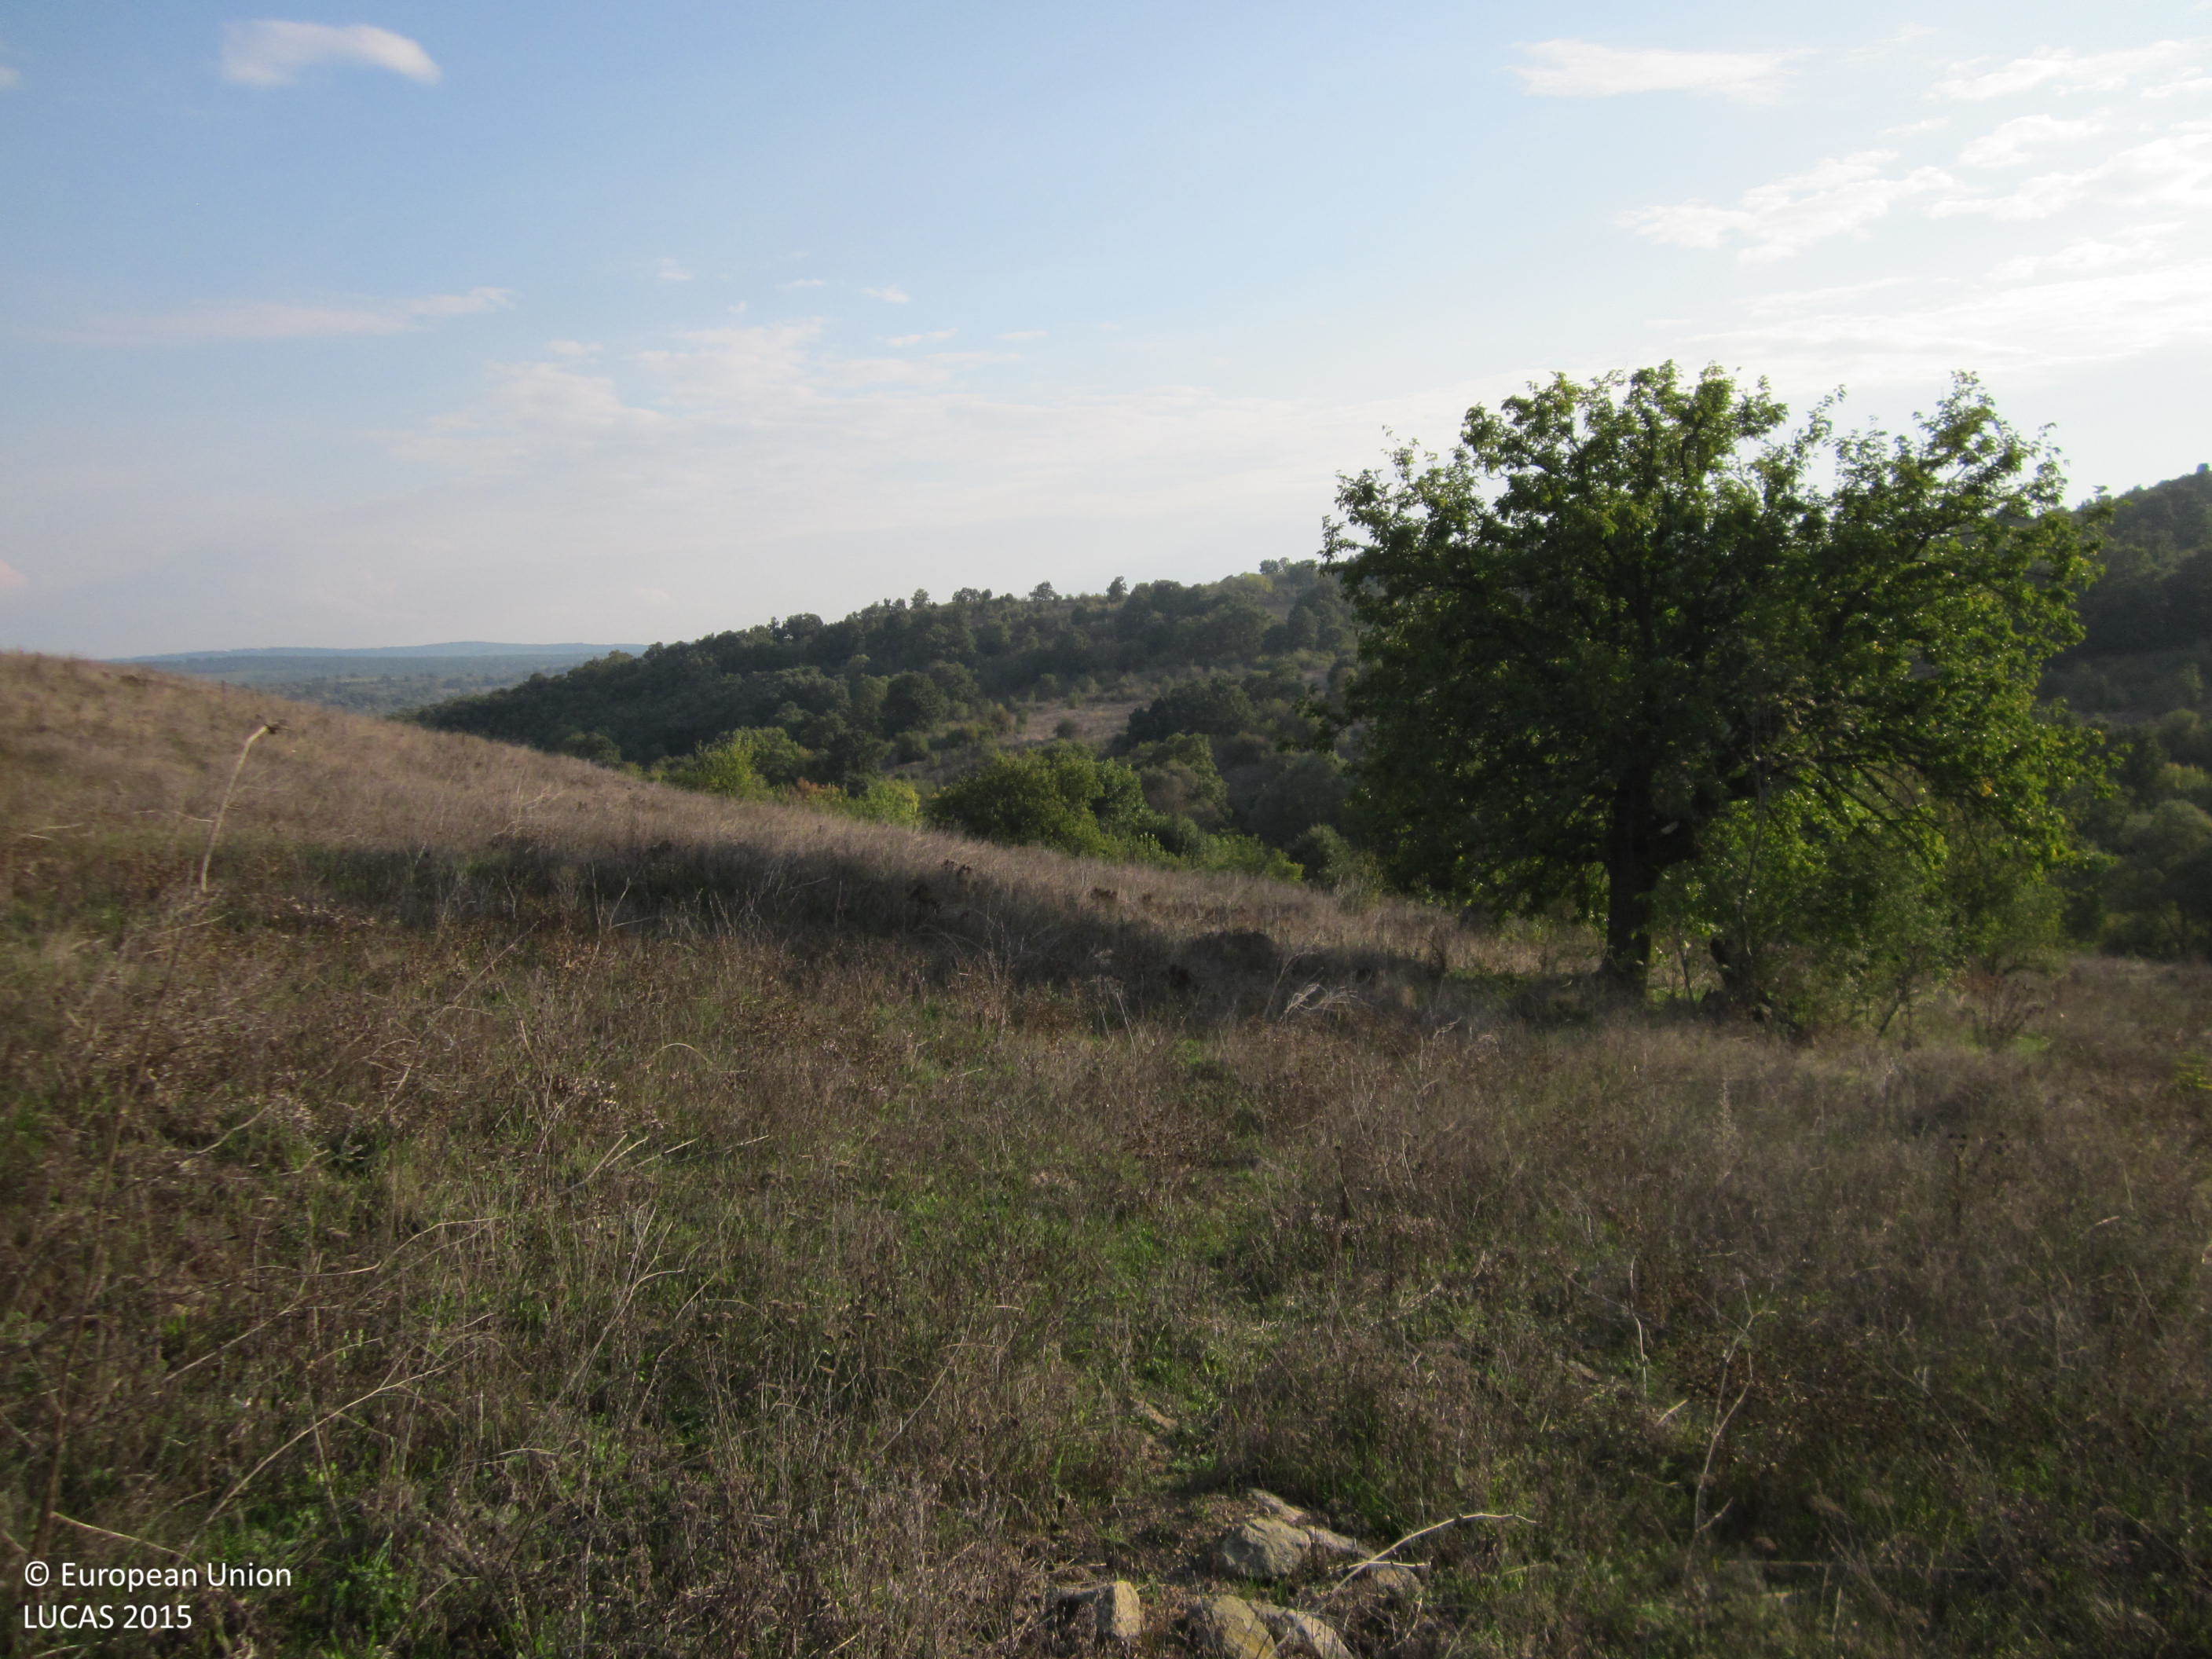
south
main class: Grassland
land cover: Grassland without tree/shrub cover
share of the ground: > 75 %
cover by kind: herbaceous plants 95 %, shrubs 5 %
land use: Agriculture (excluding fallow land and kitchen gardens)
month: October
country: BG
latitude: 42.2996
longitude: 26.9490
